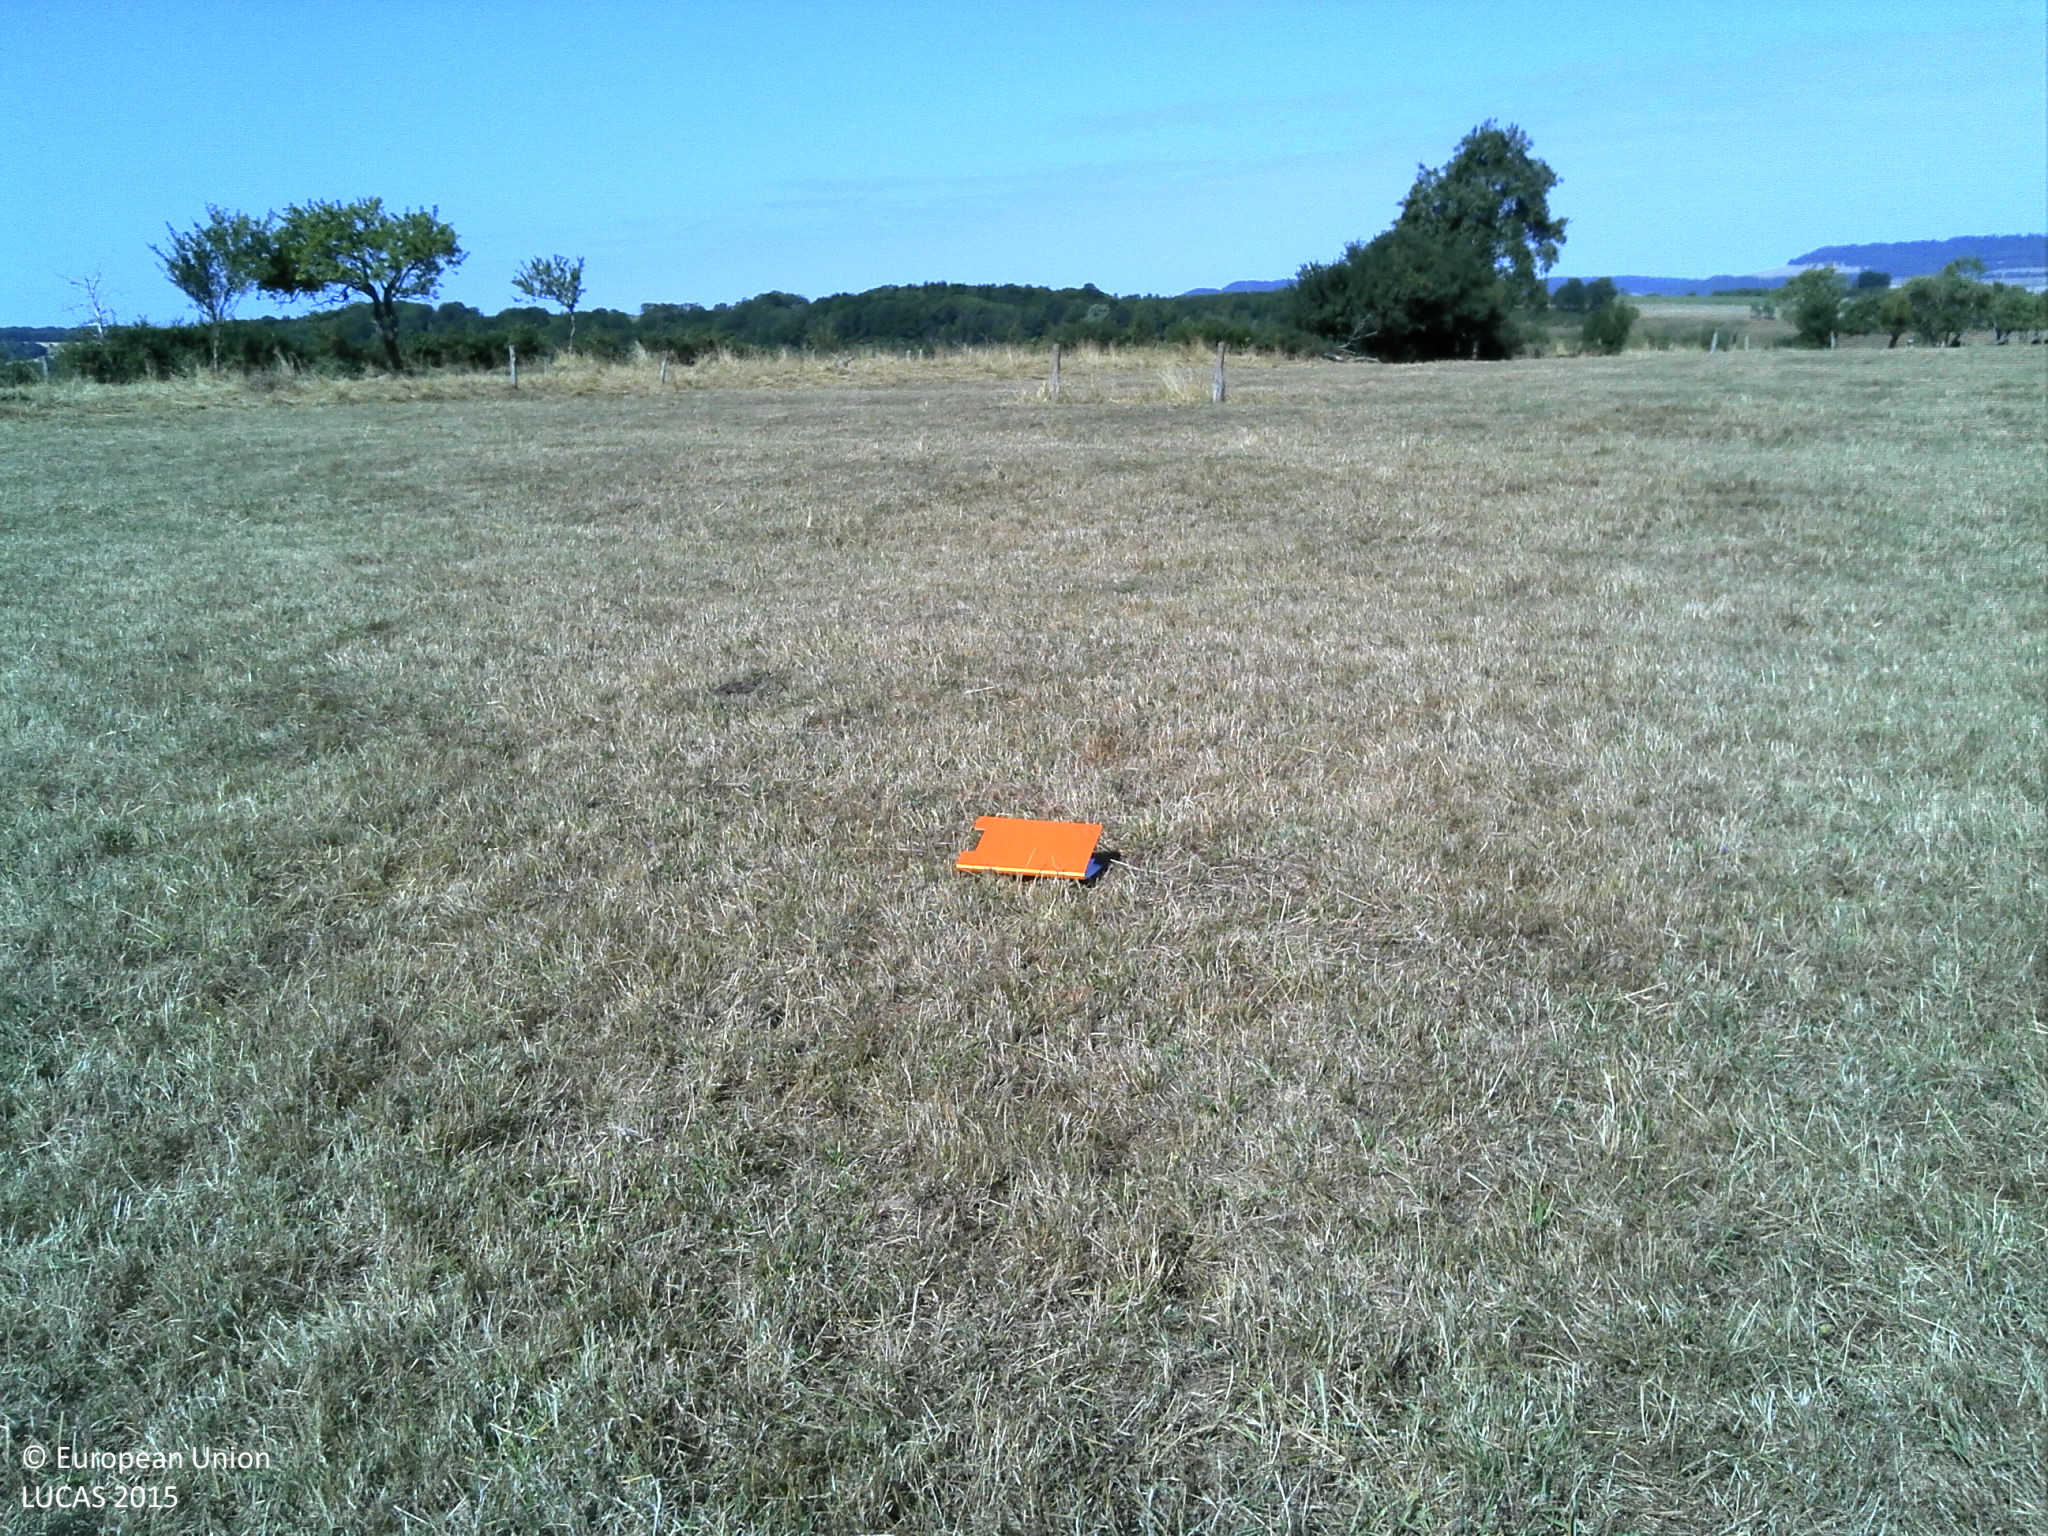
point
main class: Grassland
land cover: Grassland without tree/shrub cover
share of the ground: > 75 %
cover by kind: herbaceous plants 100 %
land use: Agriculture (excluding fallow land and kitchen gardens)
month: July
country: FR
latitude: 48.3915
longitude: 6.1784
